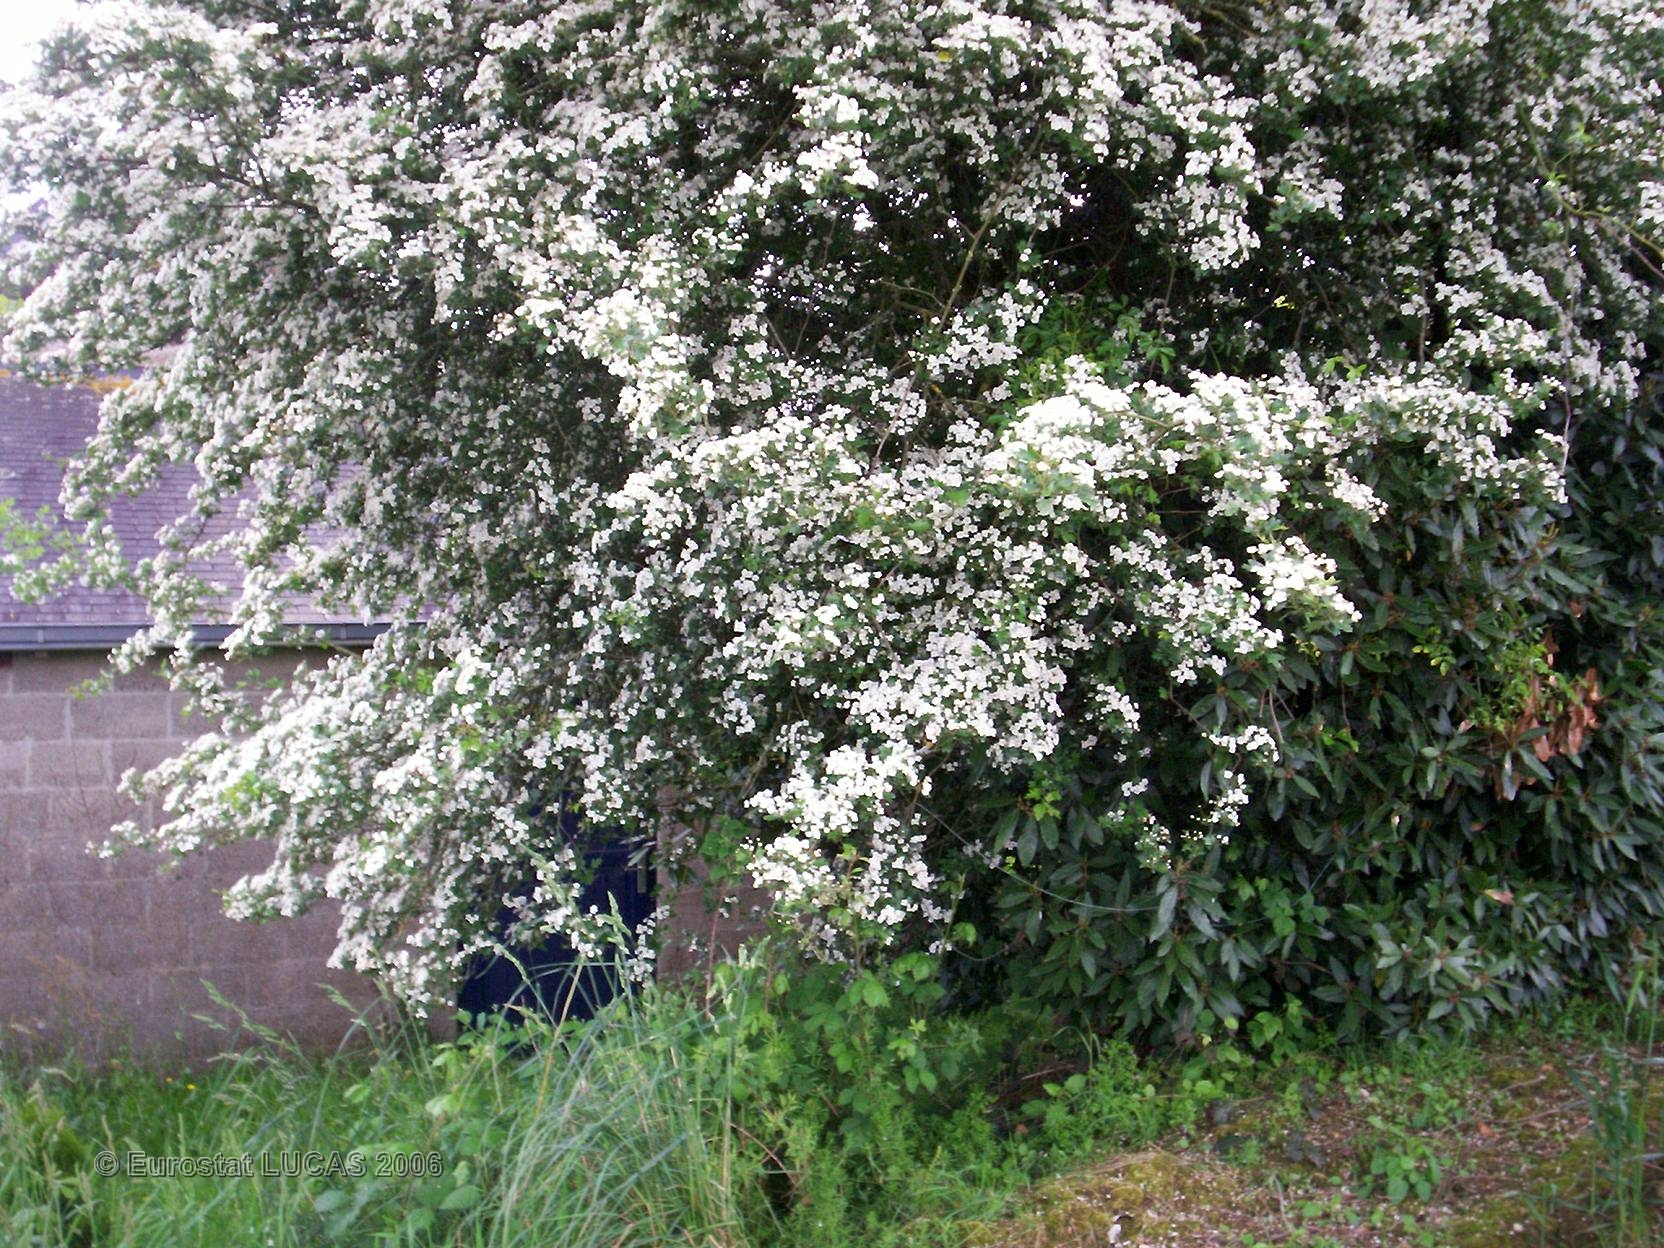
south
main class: Cropland
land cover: Common wheat
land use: Agriculture (excluding fallow land and kitchen gardens)
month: May
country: FR
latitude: 48.0733
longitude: -3.5669
